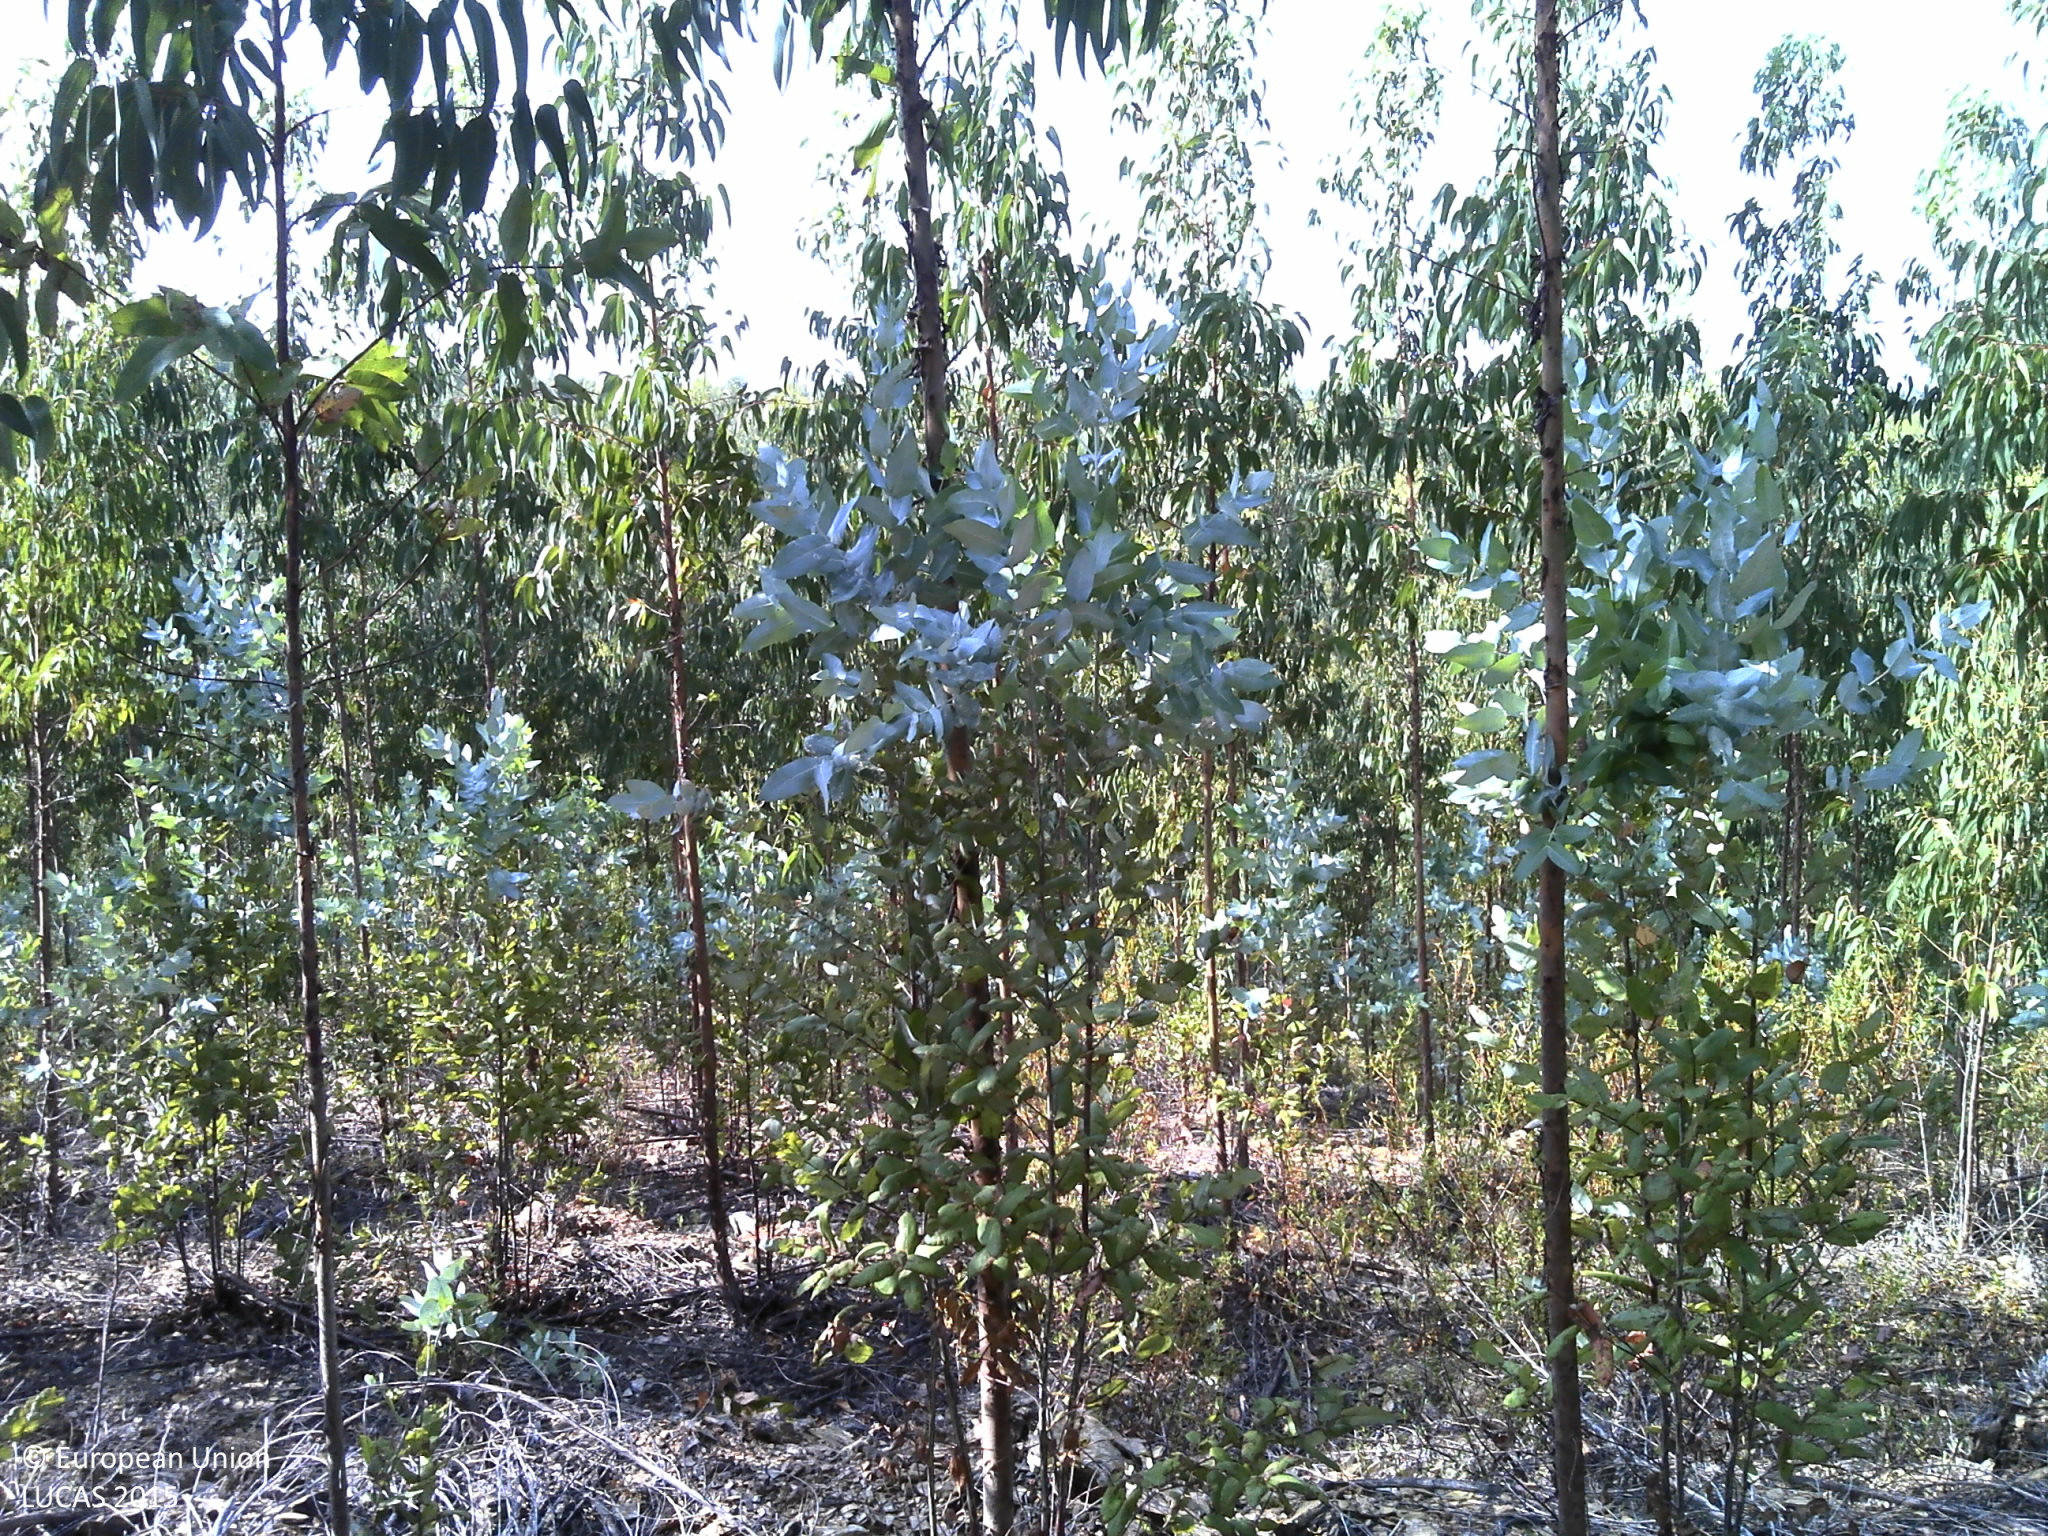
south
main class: Woodland
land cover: Broadleaved woodland
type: exotic forest
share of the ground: 50 - 75 %
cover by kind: broadleaved forest trees 50 %, consolidated bare surface 45 %, herbaceous plants 5 %
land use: Forestry
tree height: > 5 m
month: July
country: PT
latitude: 37.6790
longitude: -8.4839
